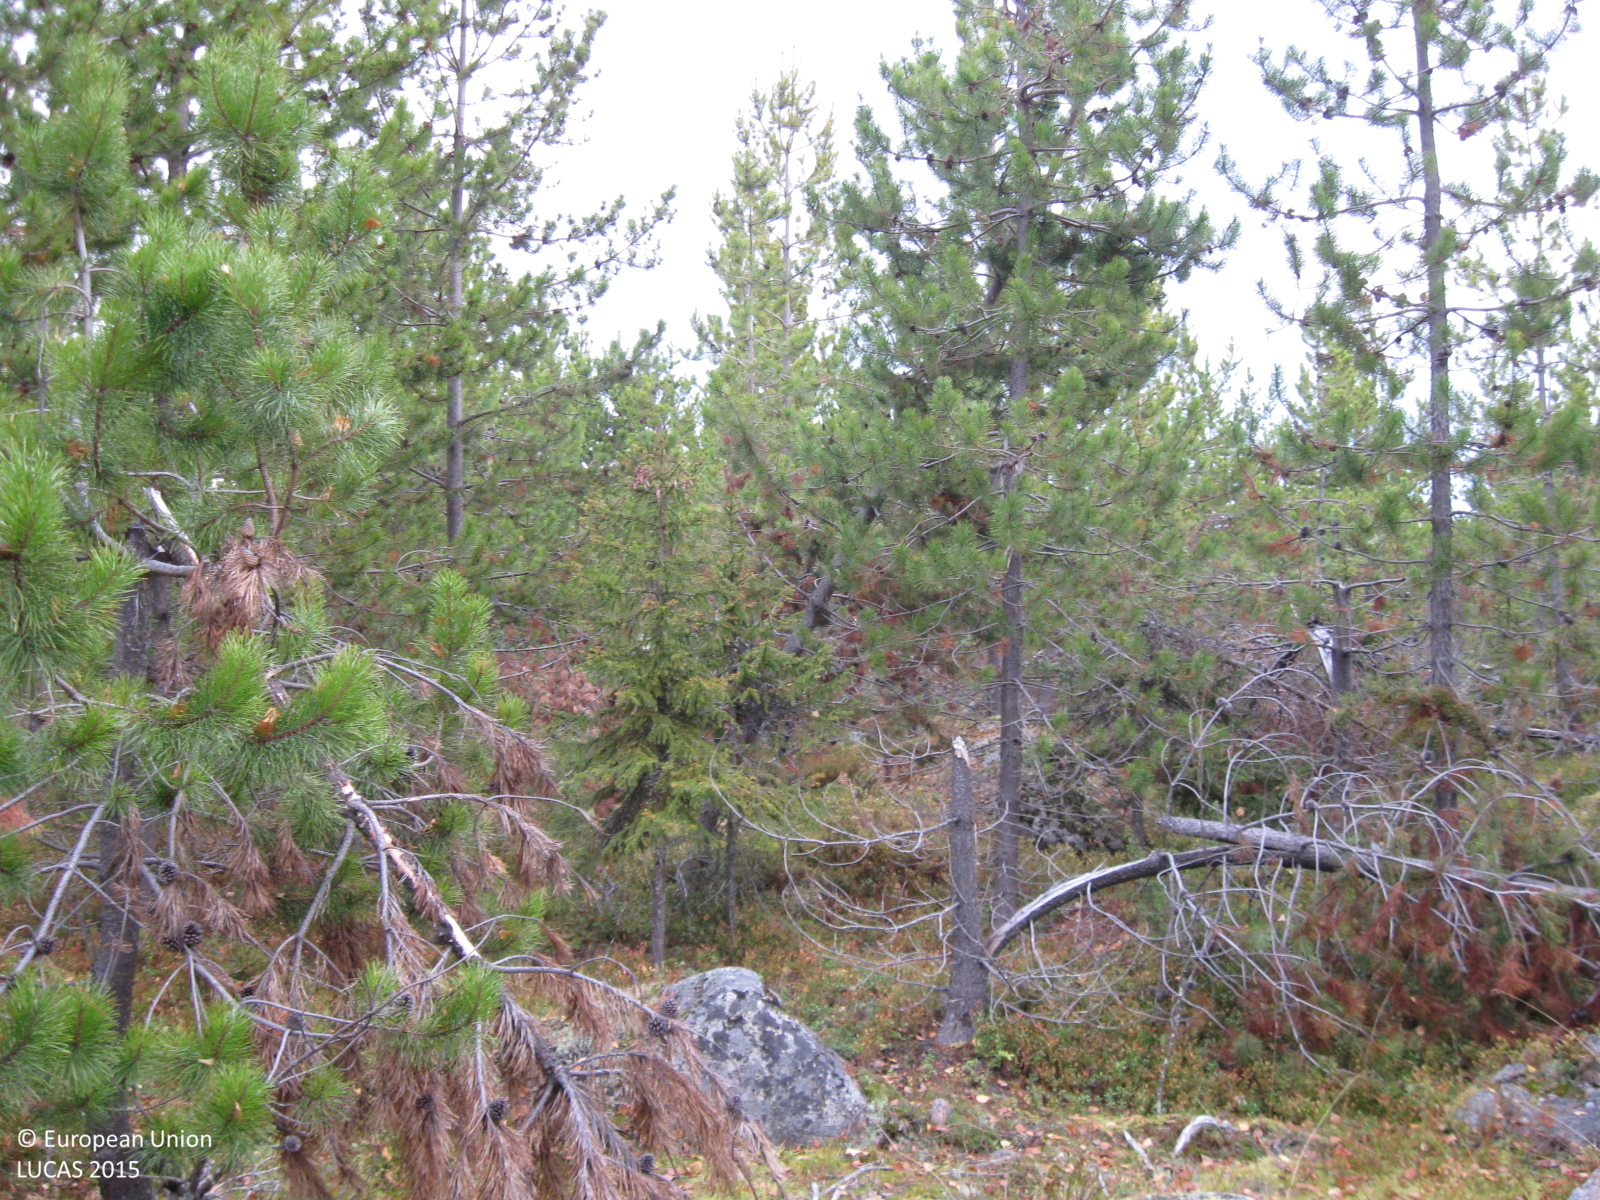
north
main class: Woodland
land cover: Pine dominated coniferous woodland
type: exotic forest
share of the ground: > 75 %
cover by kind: coniferous forest trees 80 %, broadleaved forest trees 5 %, herbaceous plants 5 %, lichens and mosses 5 %, unconsolidated bare surface 5 %
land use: Forestry
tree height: > 5 m
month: October
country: SE
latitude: 66.1070
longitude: 22.2094
